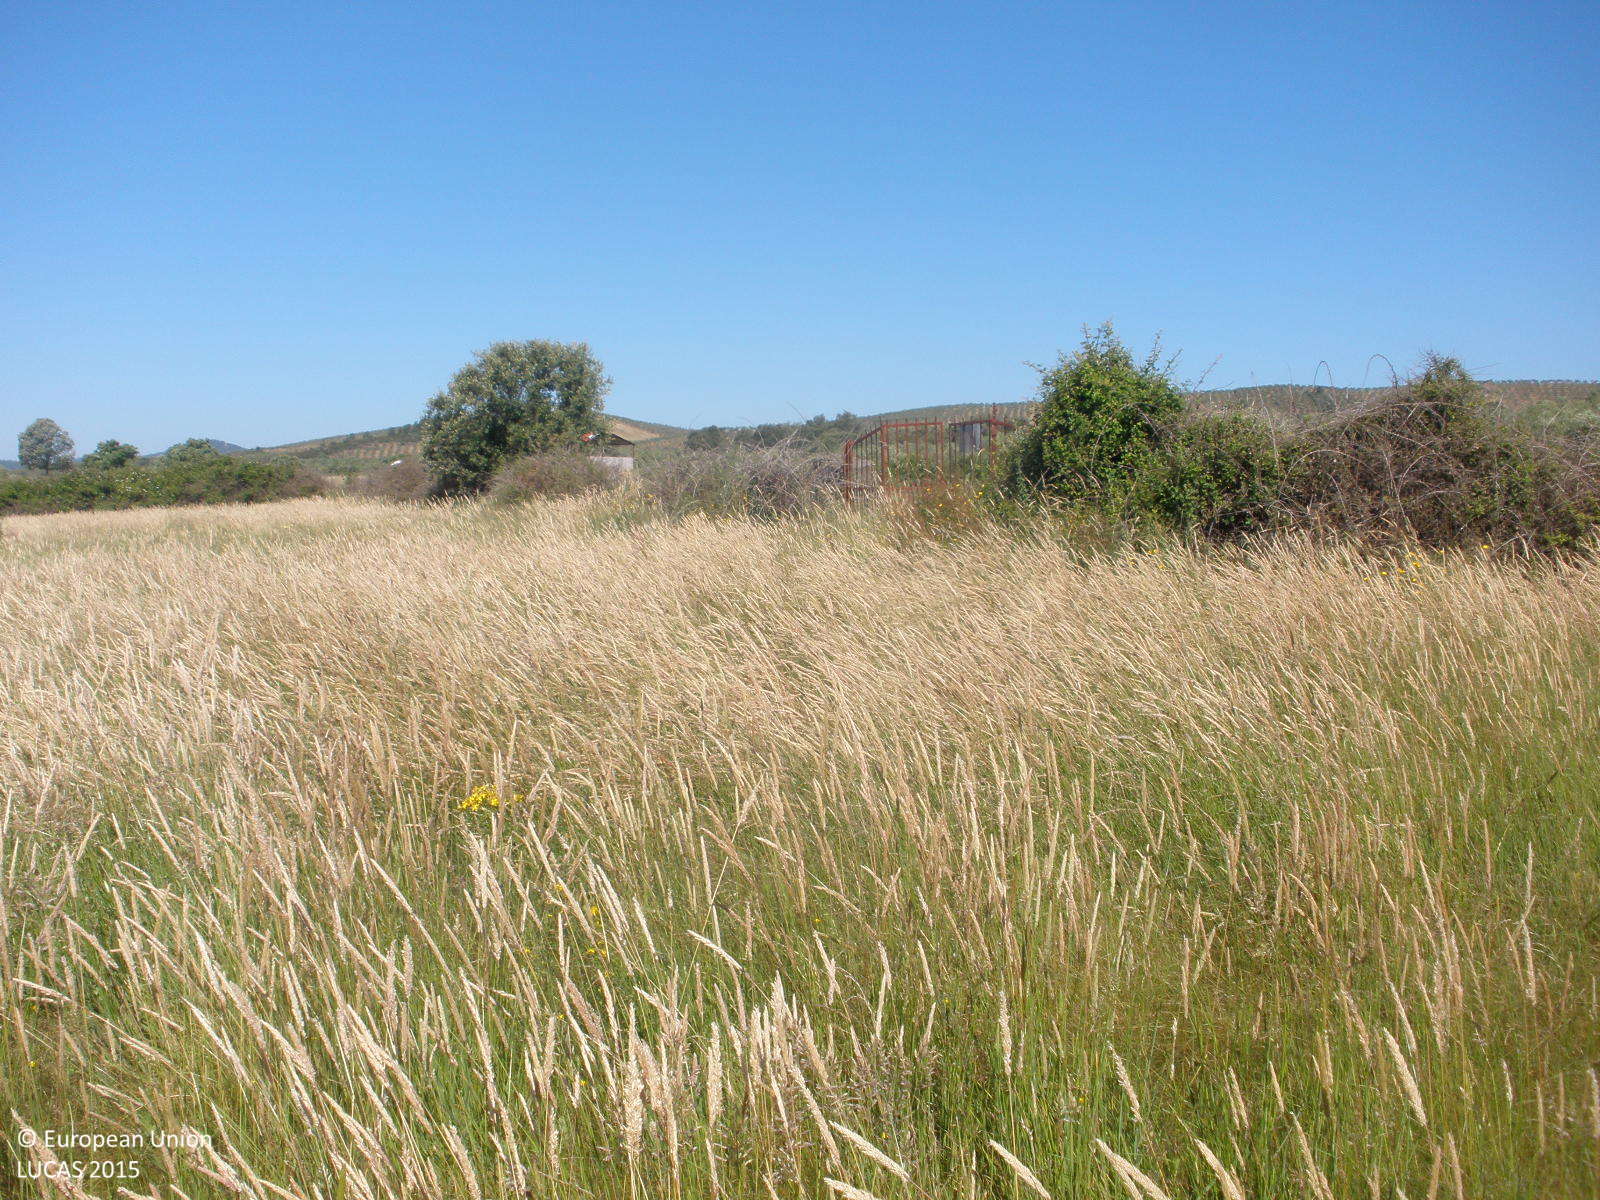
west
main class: Grassland
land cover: Grassland without tree/shrub cover
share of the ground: > 75 %
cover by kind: herbaceous plants 100 %
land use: Agriculture (excluding fallow land and kitchen gardens)
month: May
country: ES
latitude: 40.2398
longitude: -6.2883
